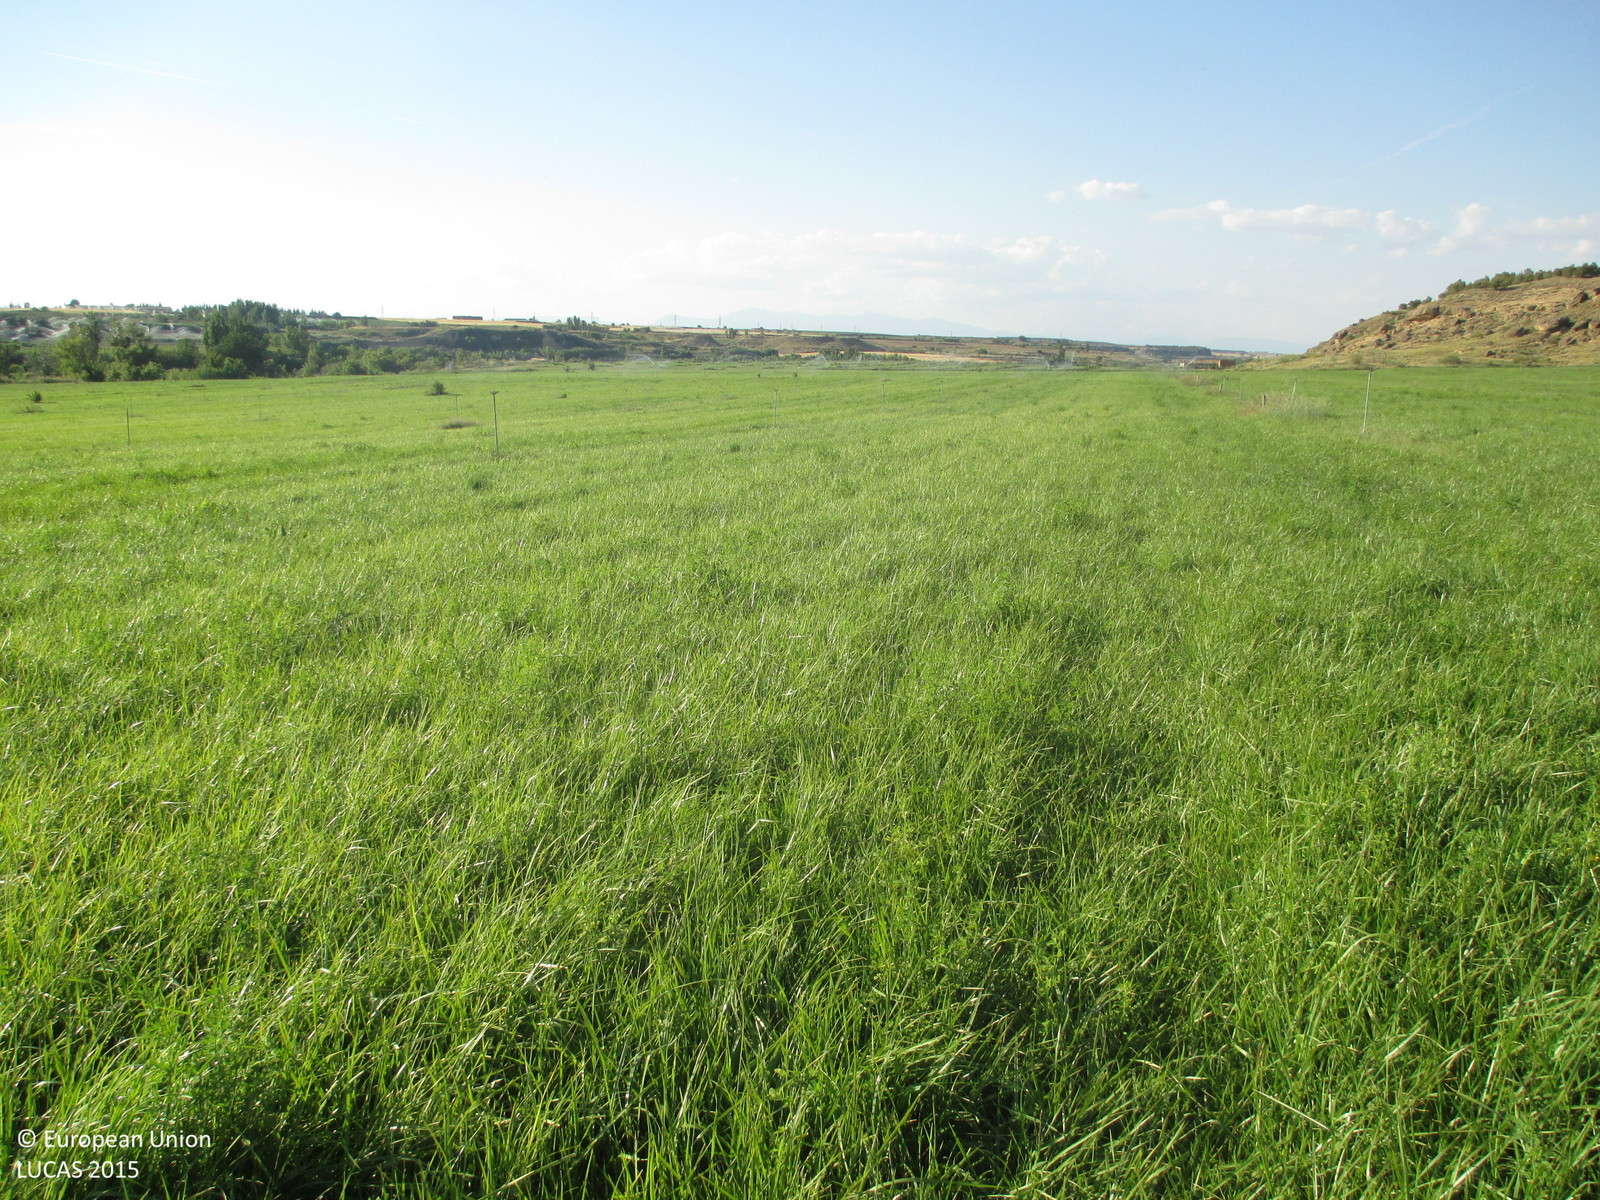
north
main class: Cropland
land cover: Other leguminous and mixtures for fodder
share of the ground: > 75 %
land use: Agriculture (excluding fallow land and kitchen gardens)
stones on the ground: 25 - 50 %
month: May
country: ES
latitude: 41.8341
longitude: -0.1452
